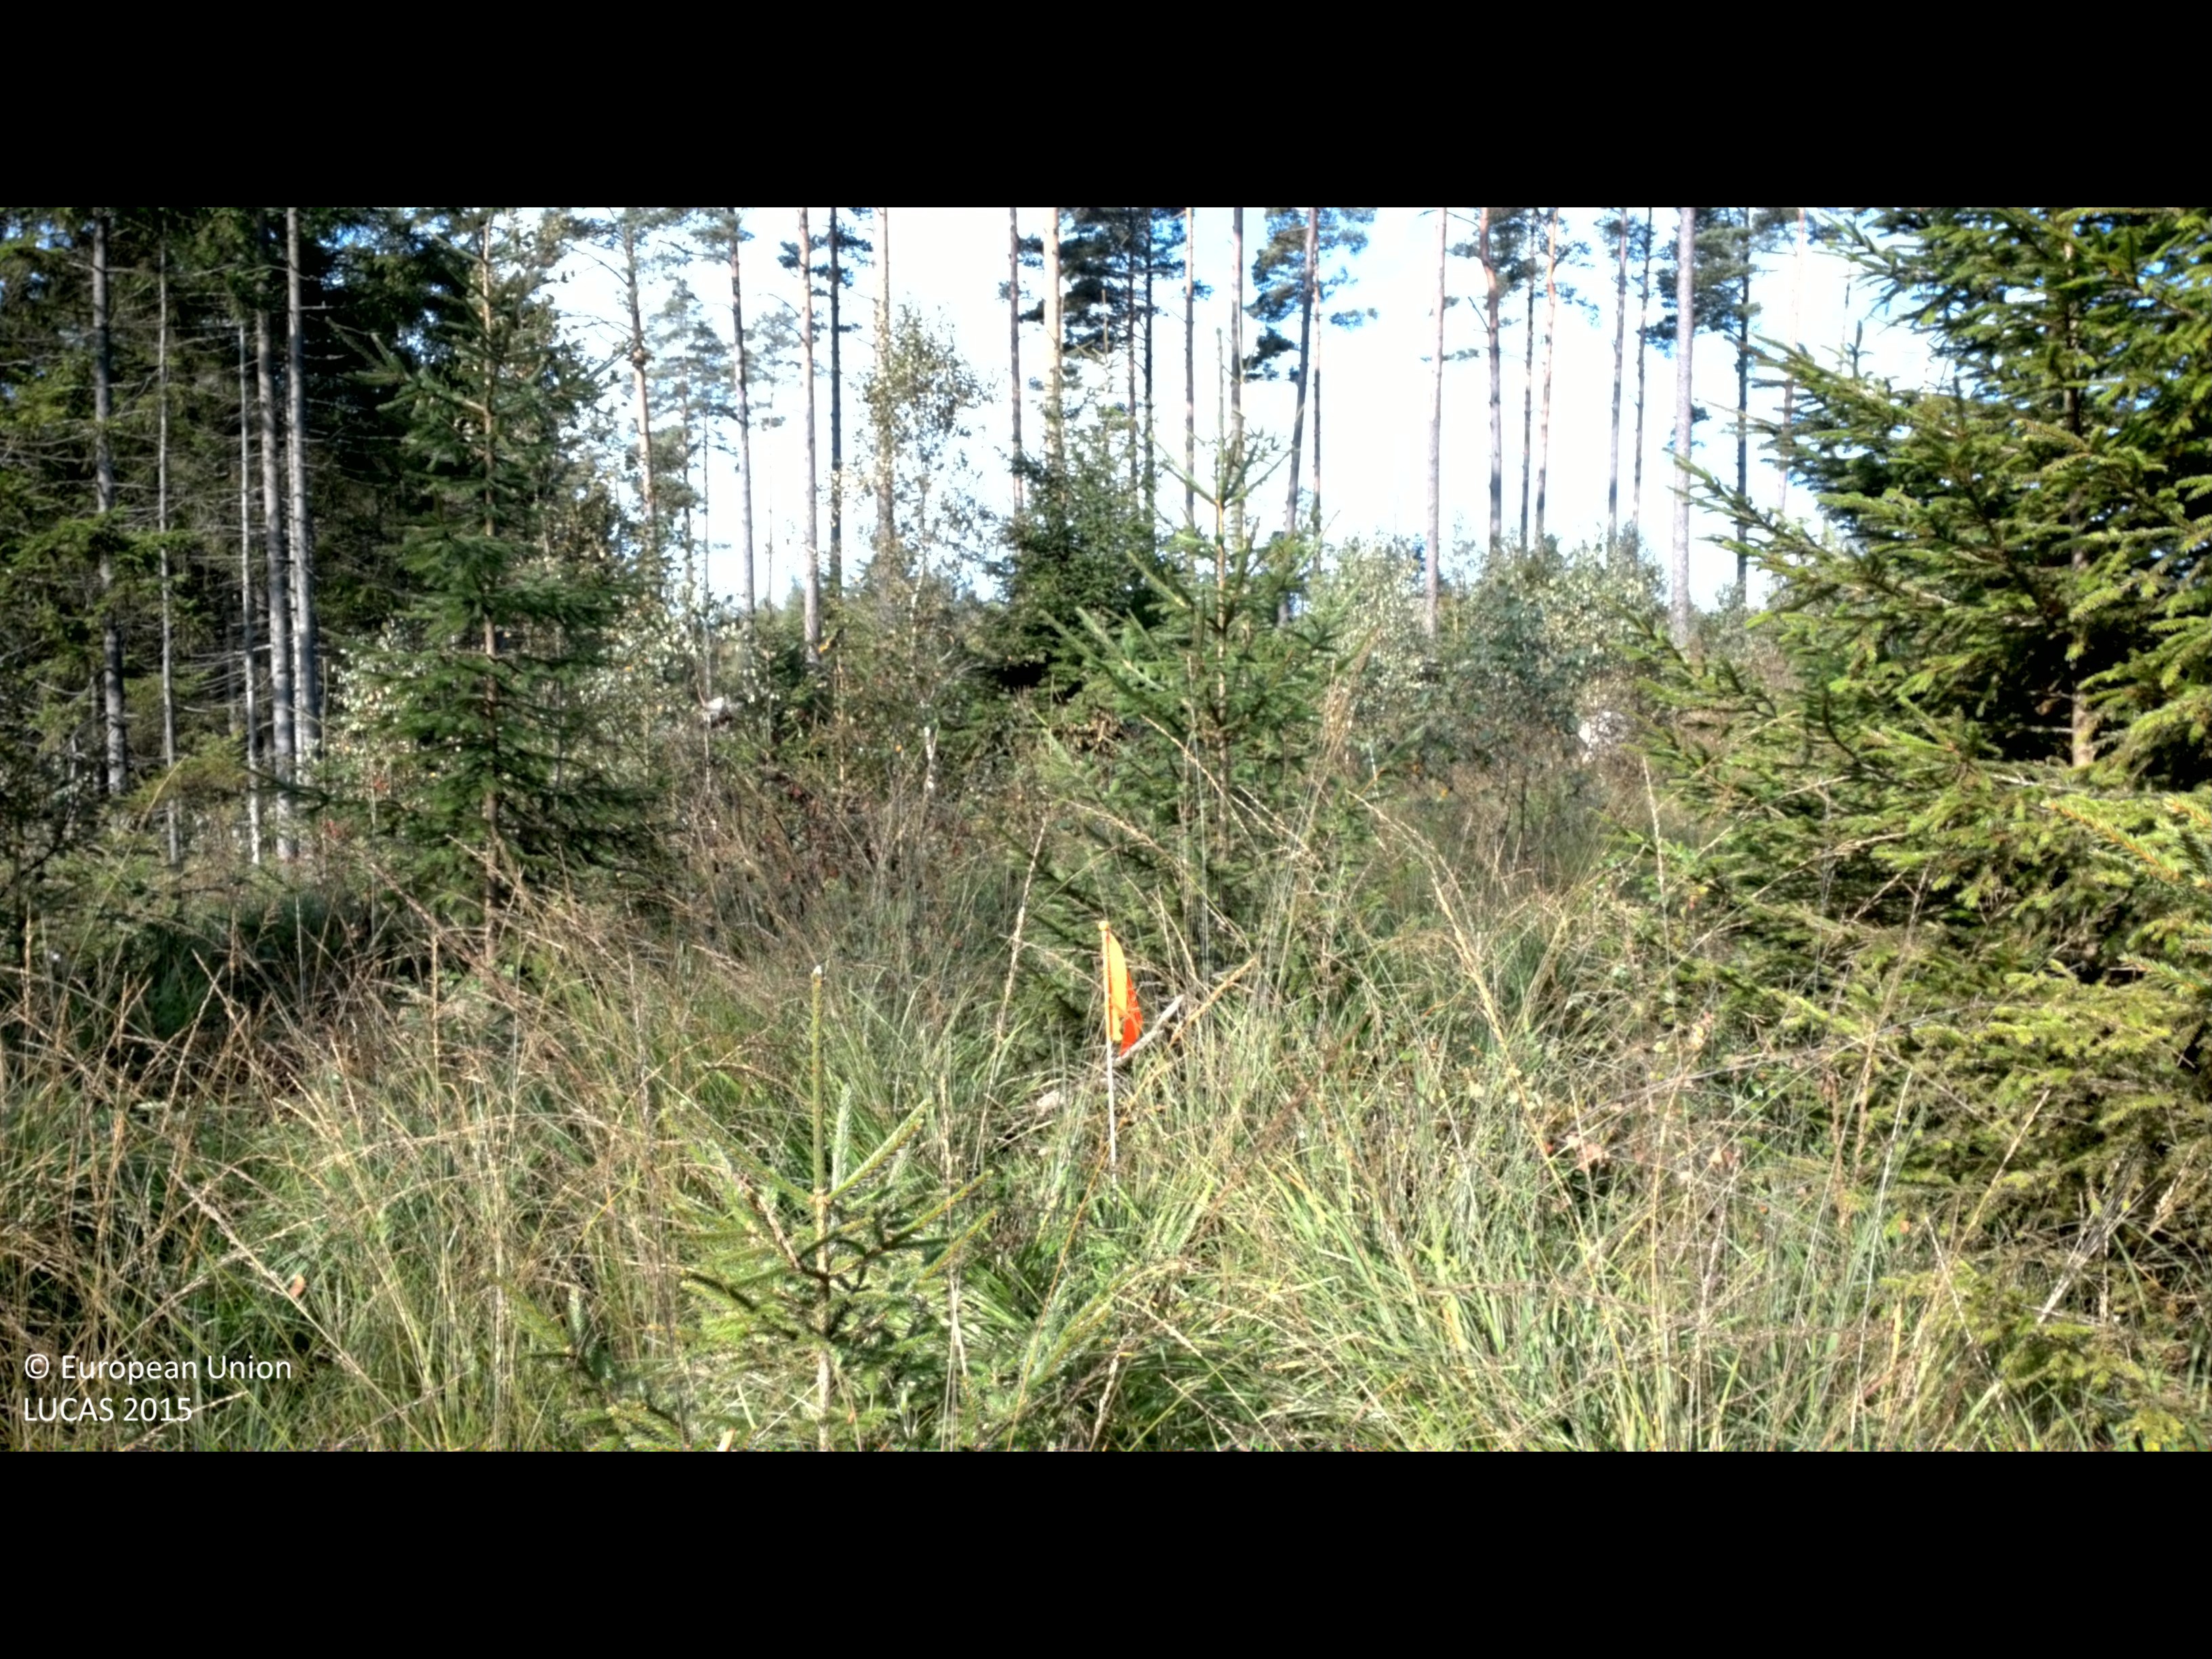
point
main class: Woodland
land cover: Spruce dominated mixed woodland
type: boreal forest
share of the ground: 50 - 75 %
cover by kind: coniferous forest trees 35 %, broadleaved forest trees 25 %, shrubs 20 %, herbaceous plants 20 %
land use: Forestry
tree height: < 5 m
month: September
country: SE
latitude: 56.8514
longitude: 13.1285
